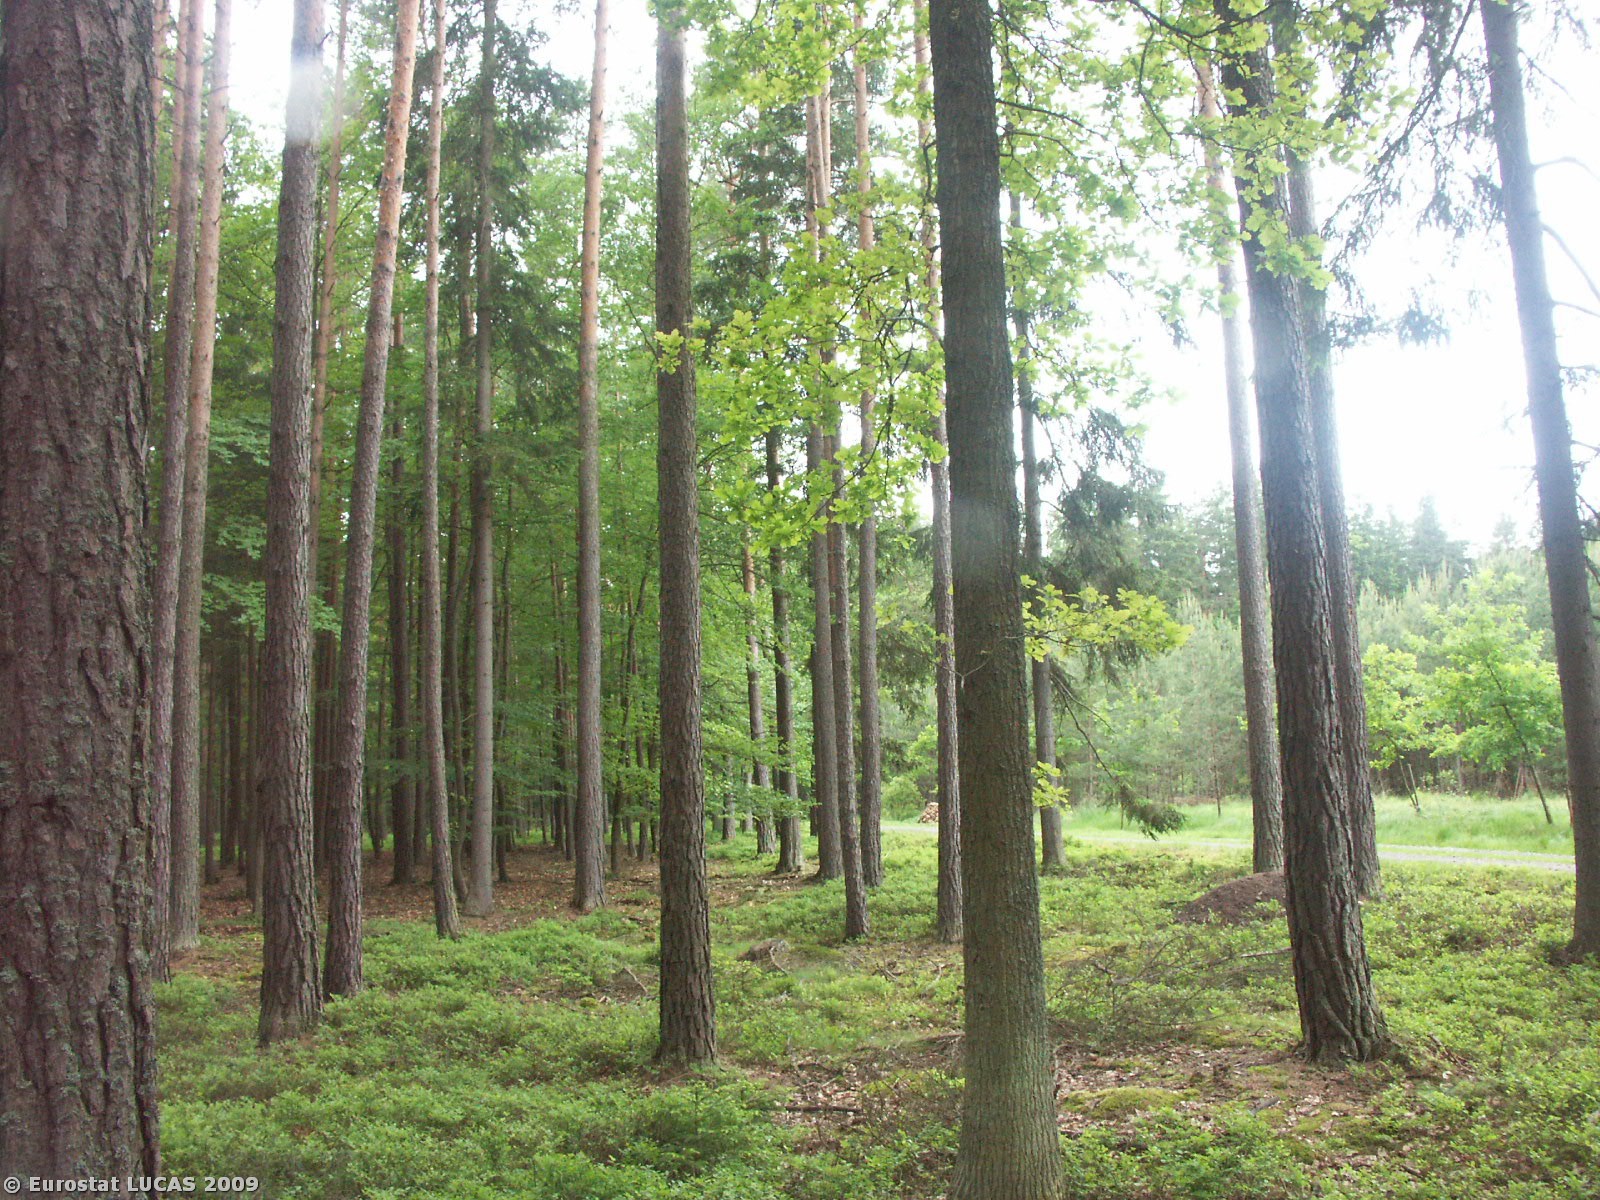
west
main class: Woodland
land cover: Mixed woodland
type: hemiboreal forest and nemoral coniferous forest and mixed broadleaved-coniferous forest
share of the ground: > 75 %
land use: Forestry
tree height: > 5 m
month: May
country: CZ
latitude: 49.0068
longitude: 14.6905
